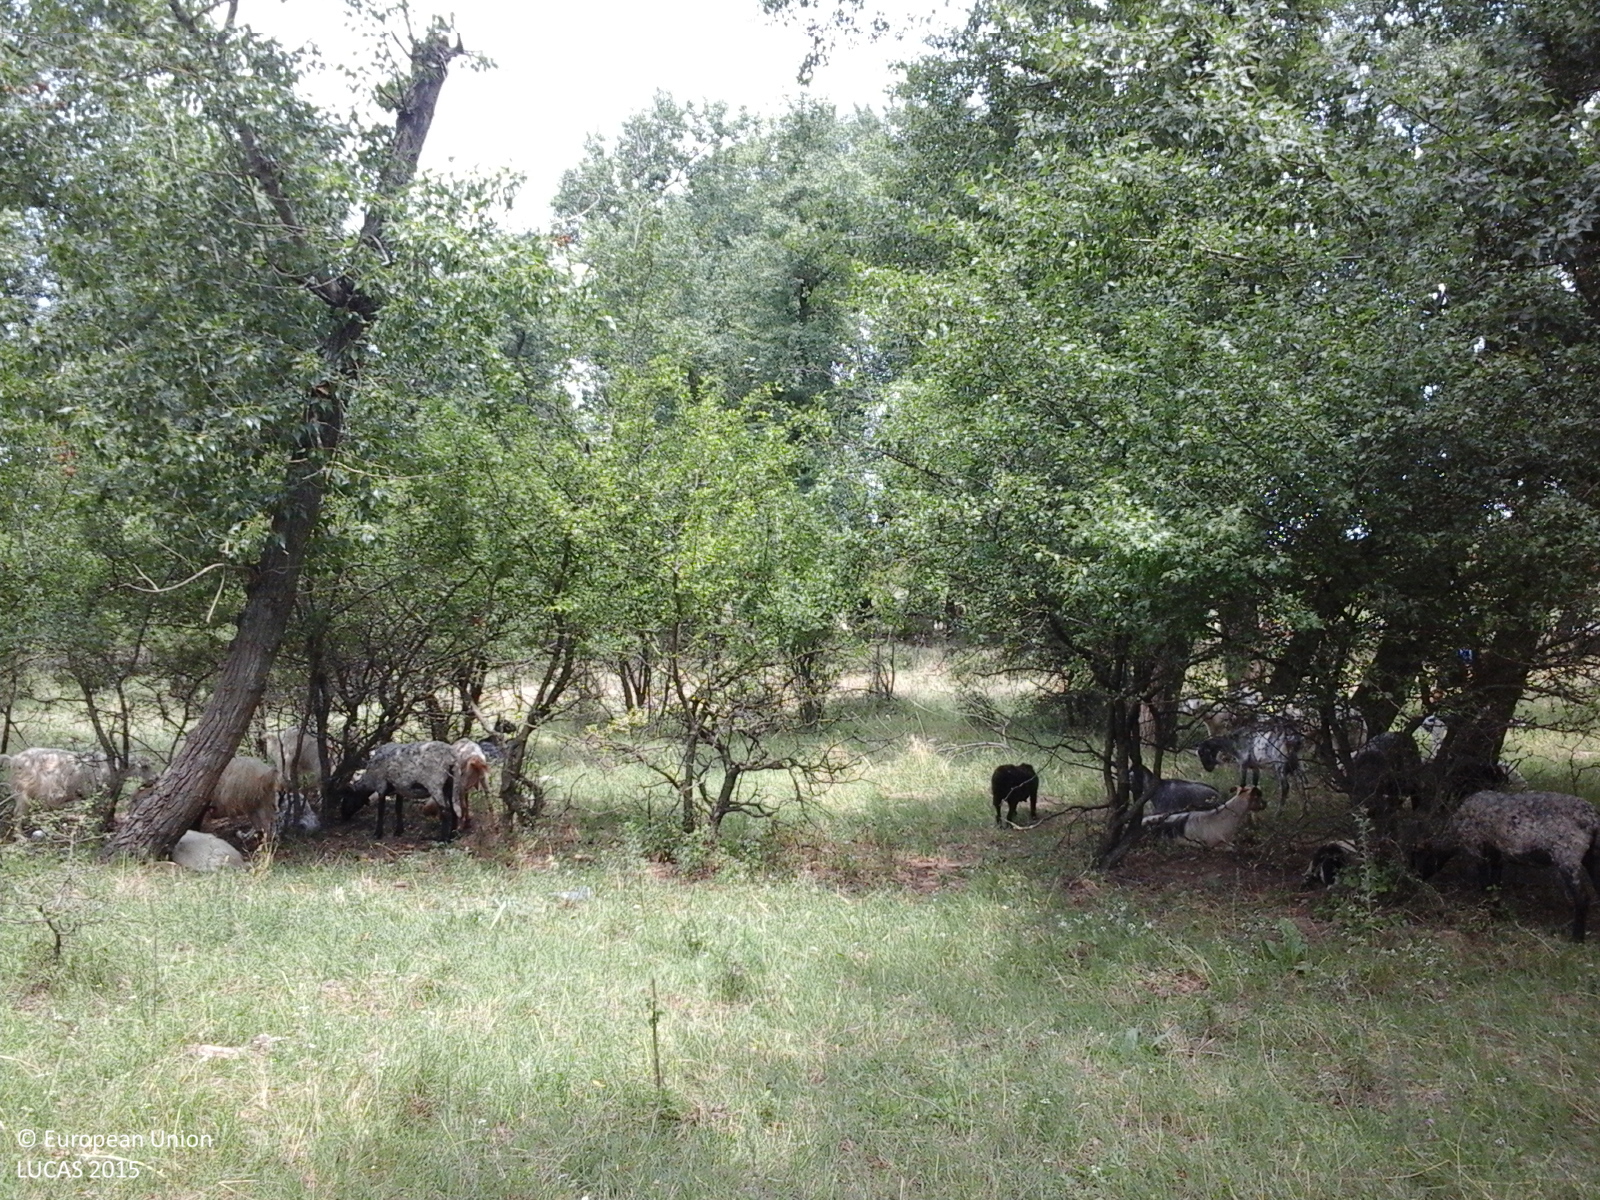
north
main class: Woodland
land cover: Broadleaved woodland
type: non-riverine alder, birch or aspen forest
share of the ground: 50 - 75 %
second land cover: Grassland without tree/shrub cover
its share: > 75 %
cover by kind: broadleaved forest trees 60 %, herbaceous plants 40 %
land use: Forestry
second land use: Agriculture (excluding fallow land and kitchen gardens)
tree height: > 5 m
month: July
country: RO
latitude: 43.9719
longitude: 24.5896
